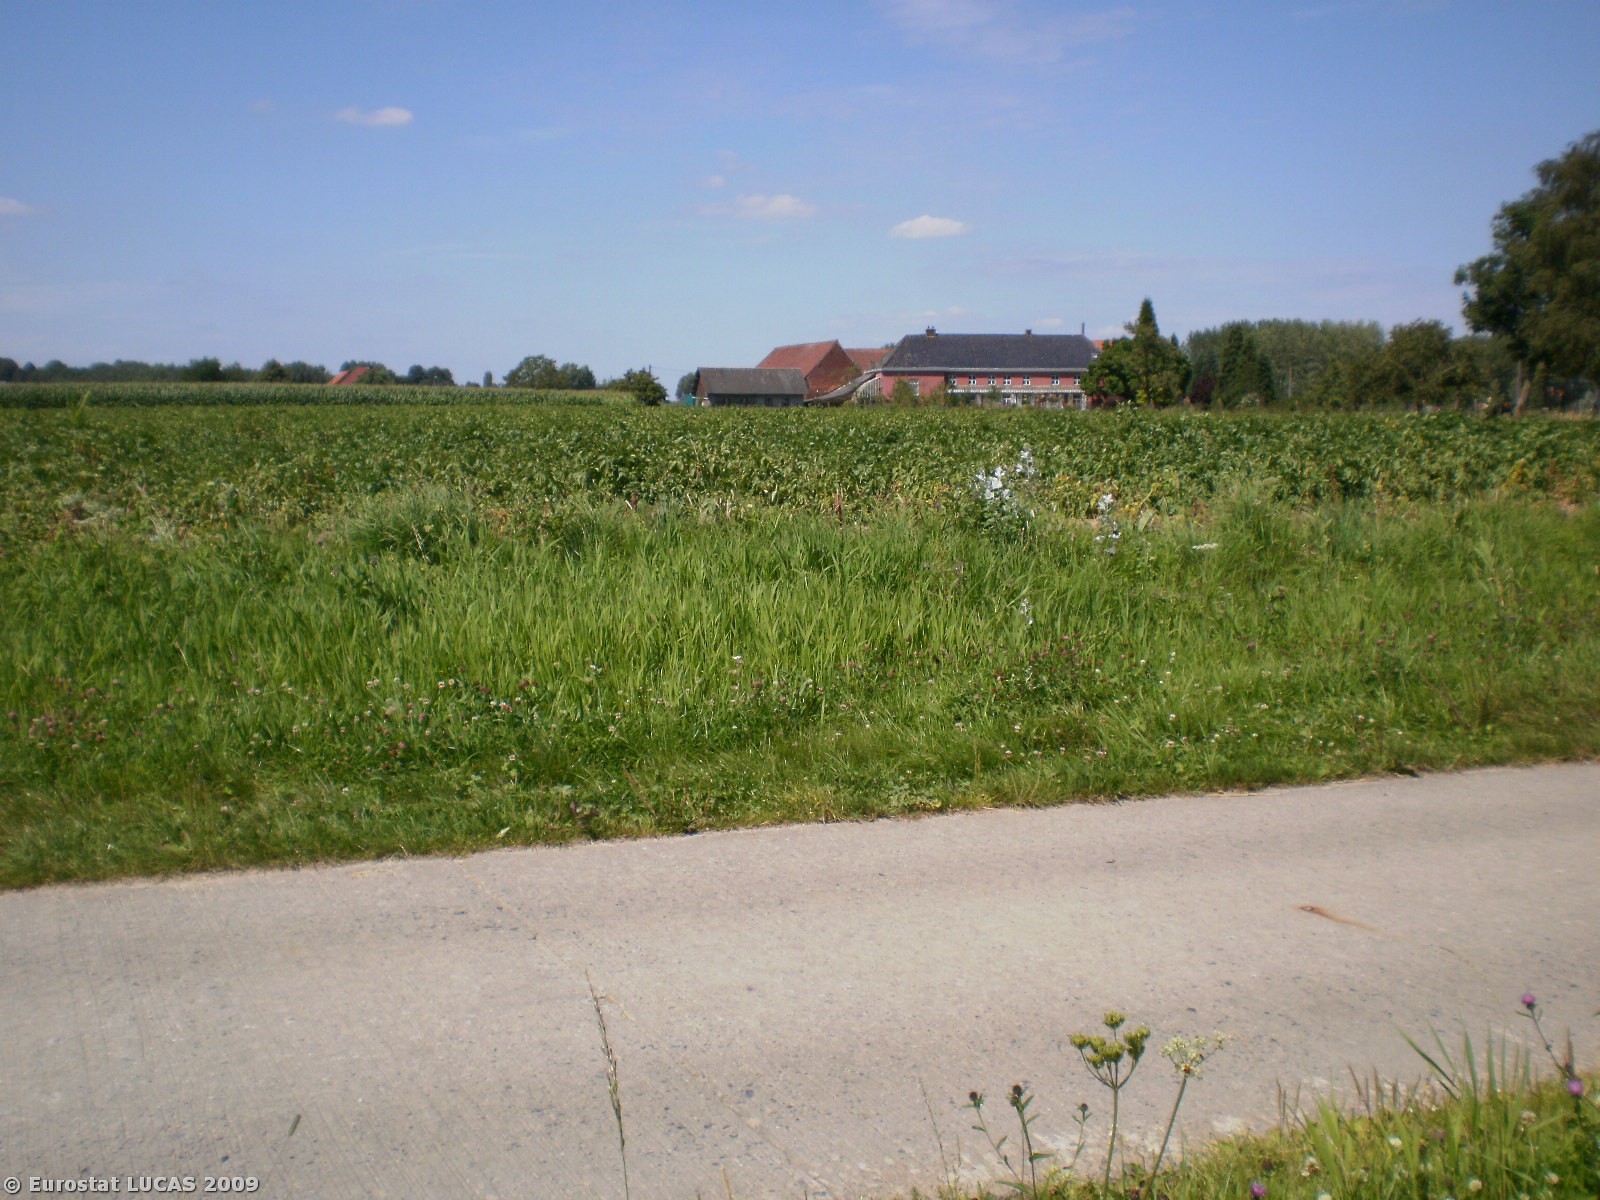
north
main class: Grassland
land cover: Grassland without tree/shrub cover
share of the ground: > 75 %
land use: Agriculture (excluding fallow land and kitchen gardens)
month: August
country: BE
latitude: 50.7907
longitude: 3.7942
